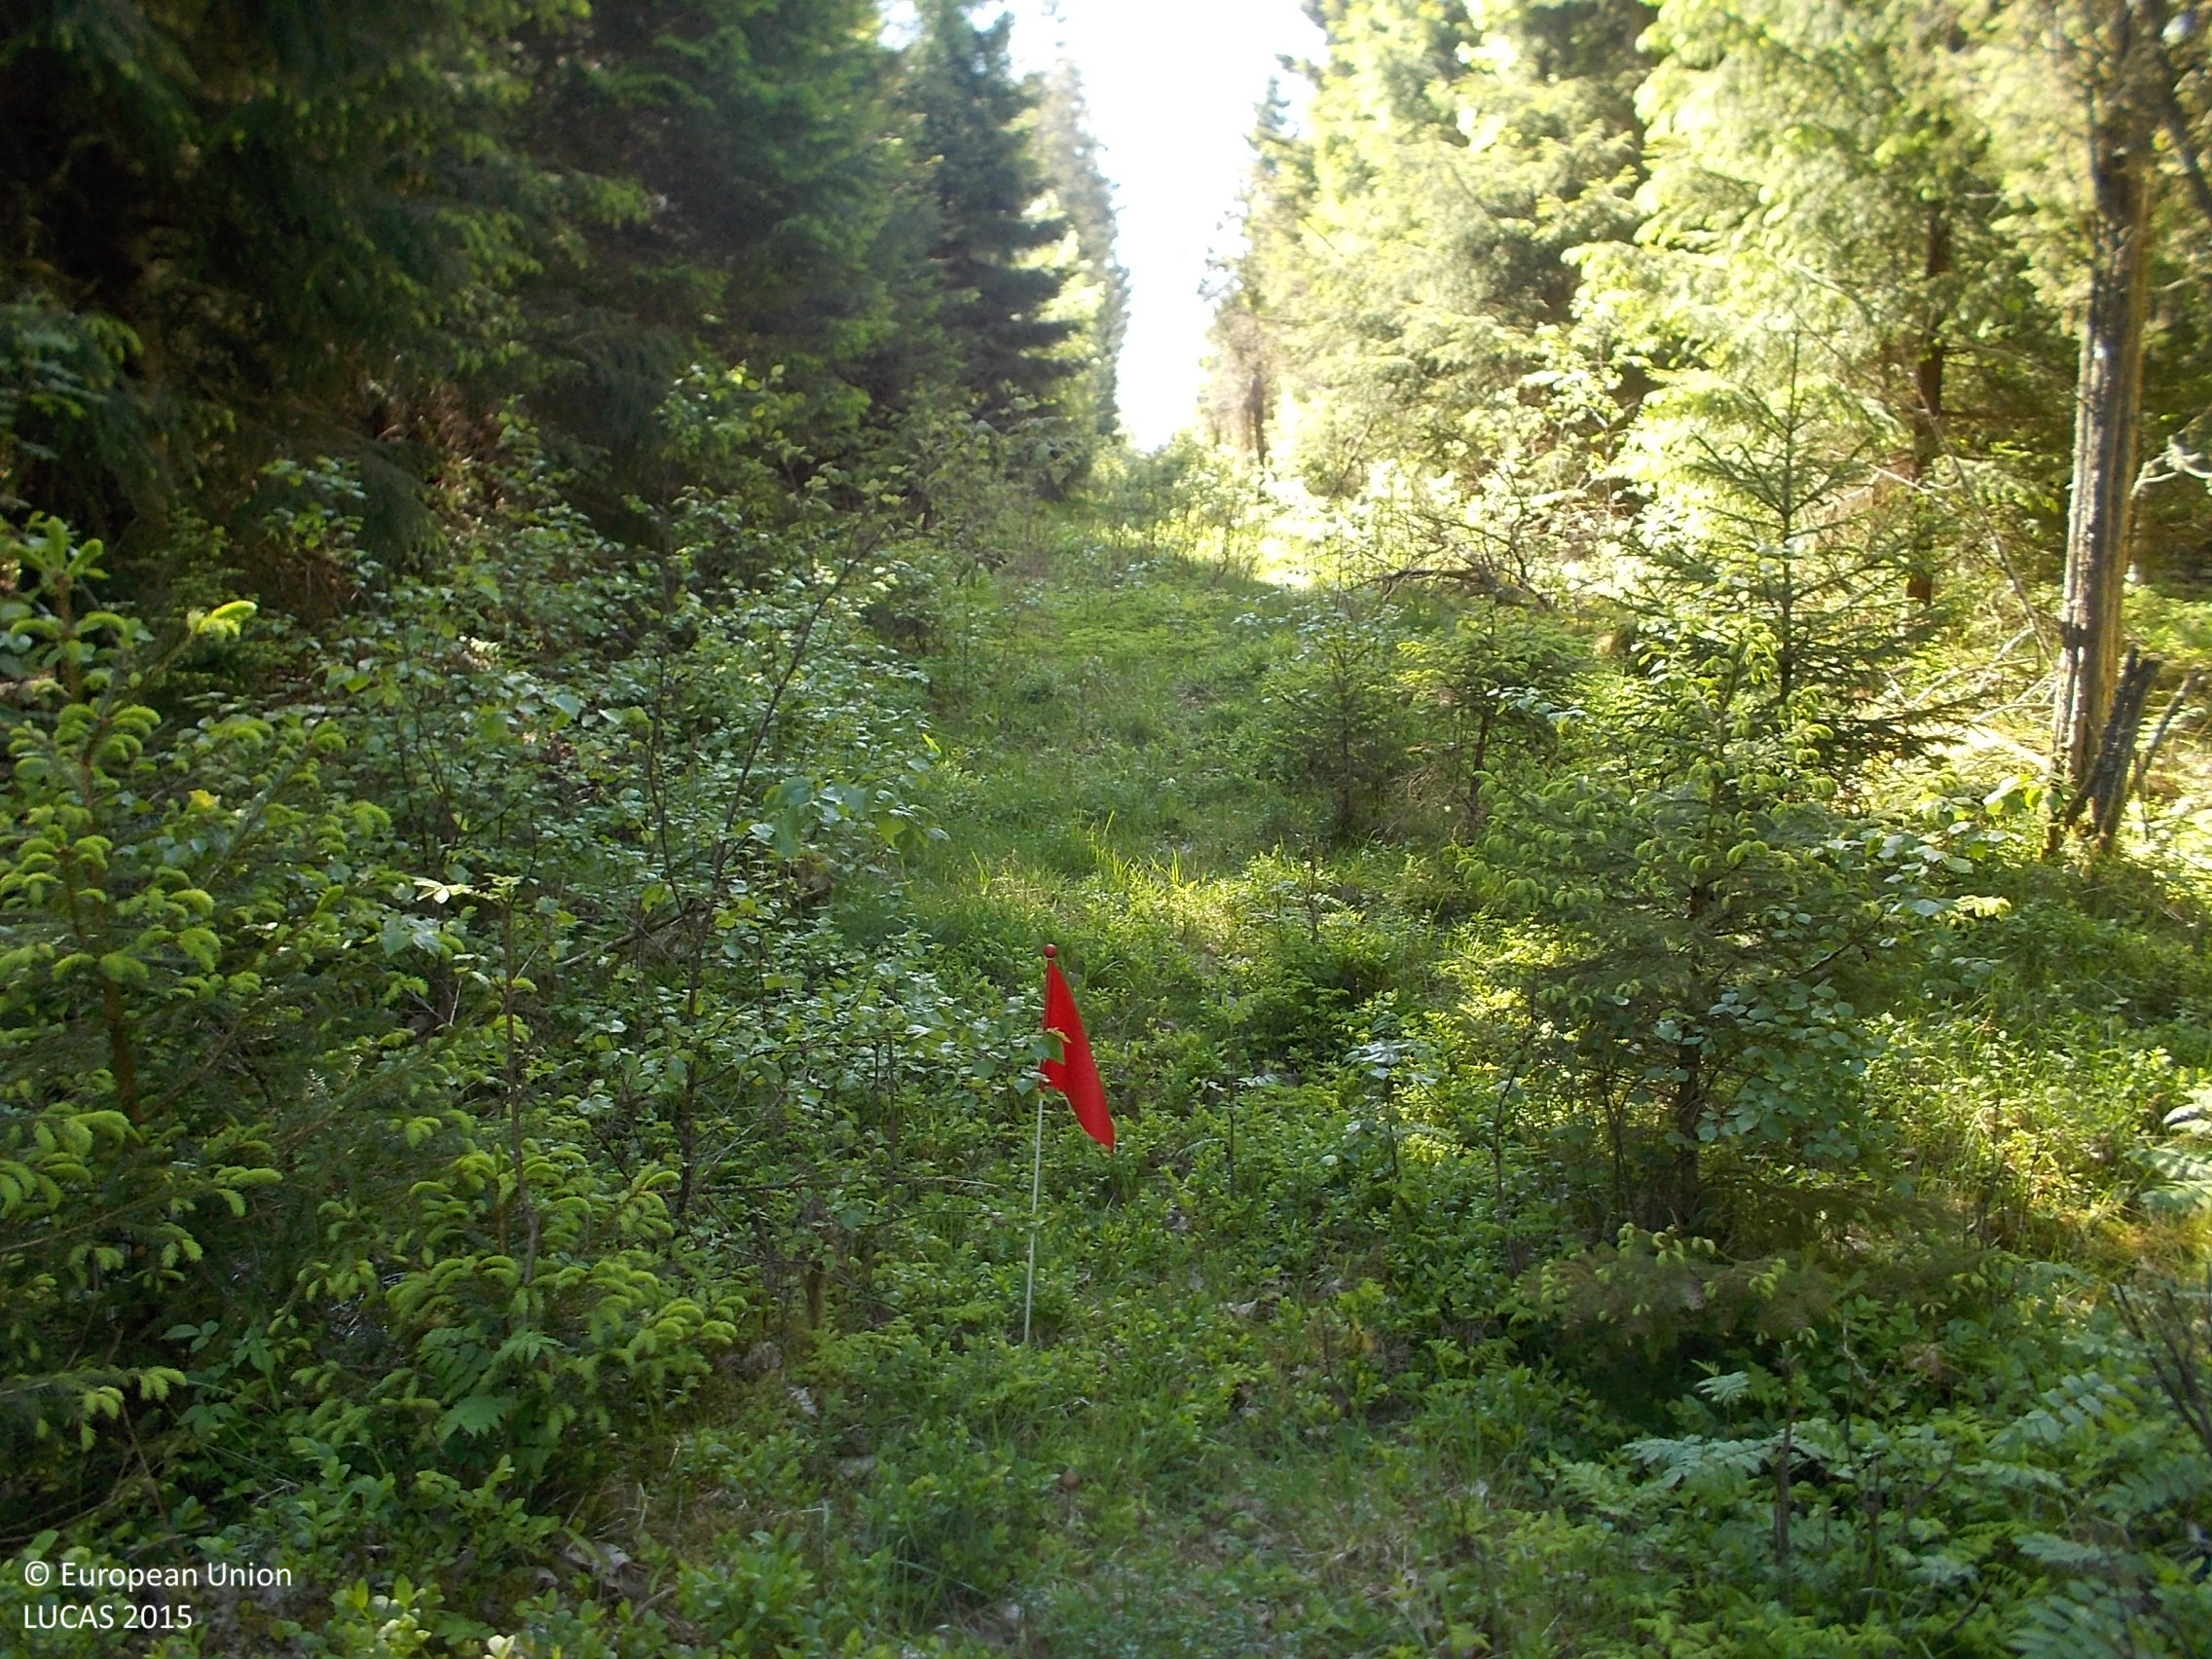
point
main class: Woodland
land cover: Spruce dominated mixed woodland
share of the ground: 25 - 50 %
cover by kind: shrubs 40 %, coniferous forest trees 25 %, broadleaved forest trees 25 %, herbaceous plants 10 %
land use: Forestry
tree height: < 5 m
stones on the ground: < 10 %
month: June
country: SE
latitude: 57.8056
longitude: 13.1085
